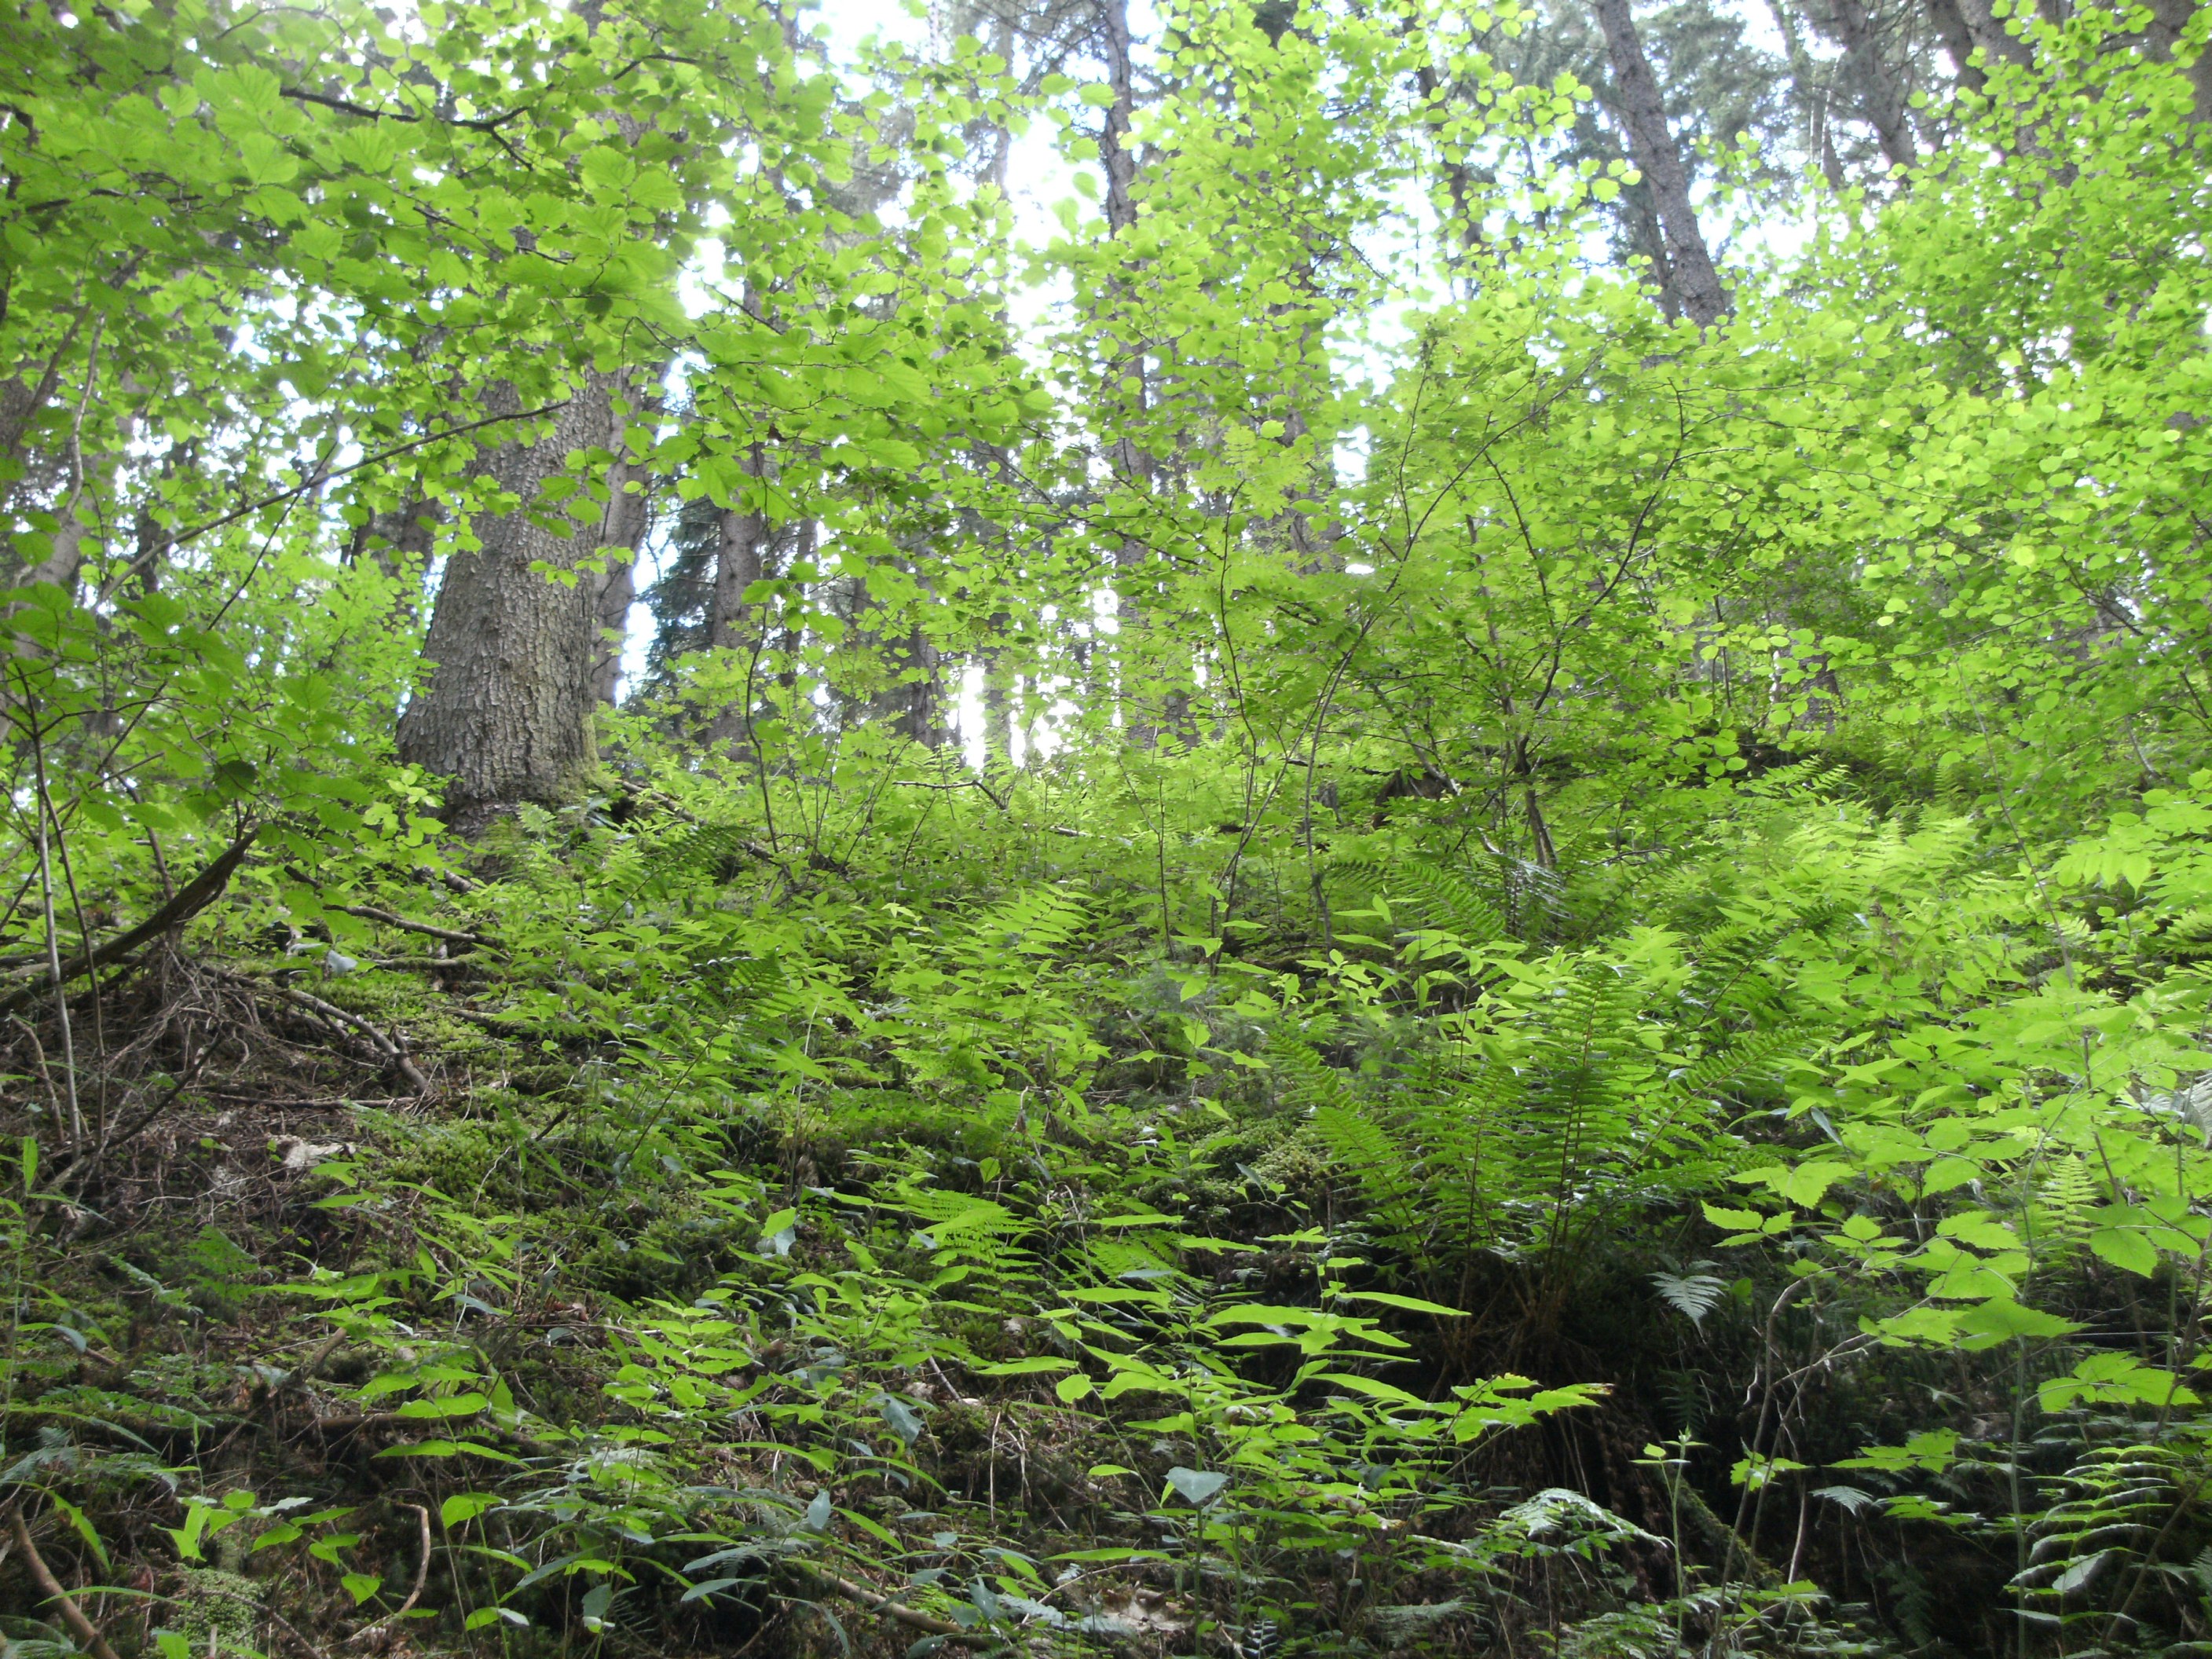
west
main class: Woodland
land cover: Spruce dominated mixed woodland
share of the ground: > 75 %
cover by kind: coniferous forest trees 45 %, broadleaved forest trees 30 %, shrubs 10 %, herbaceous plants 10 %, unconsolidated bare surface 5 %
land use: Forestry
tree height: > 5 m
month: July
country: AT
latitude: 46.8239
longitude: 14.7303
